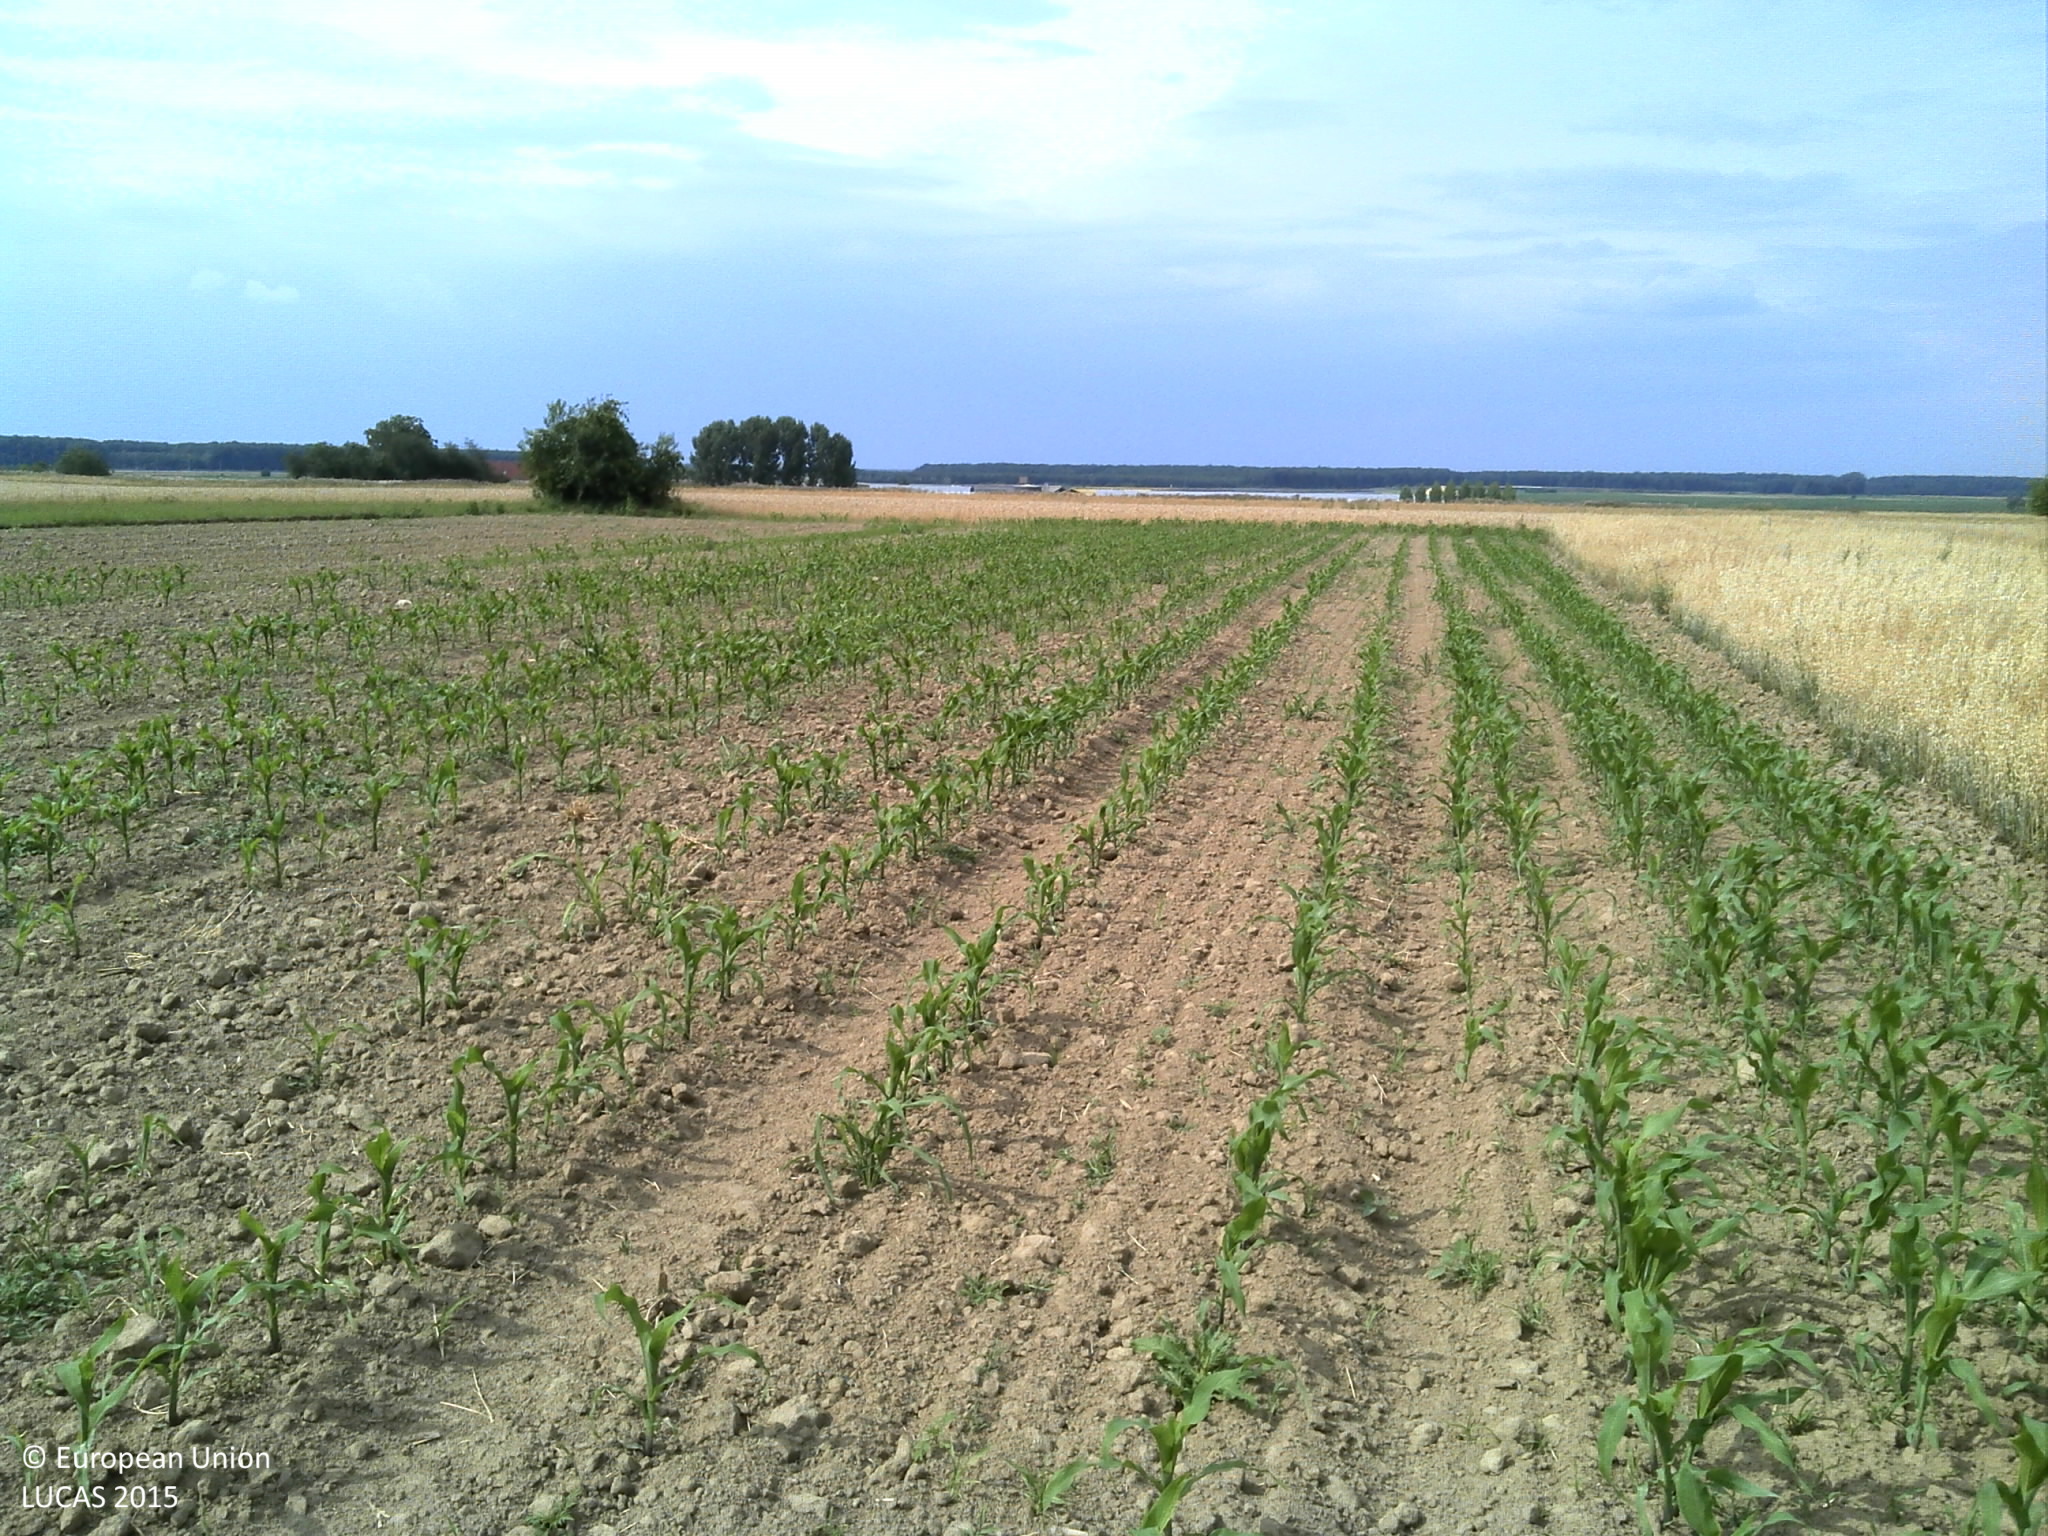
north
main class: Cropland
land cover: Maize
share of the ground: 10 - 25 %
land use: Agriculture (excluding fallow land and kitchen gardens)
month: June
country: HR
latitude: 45.3848
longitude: 18.4219
